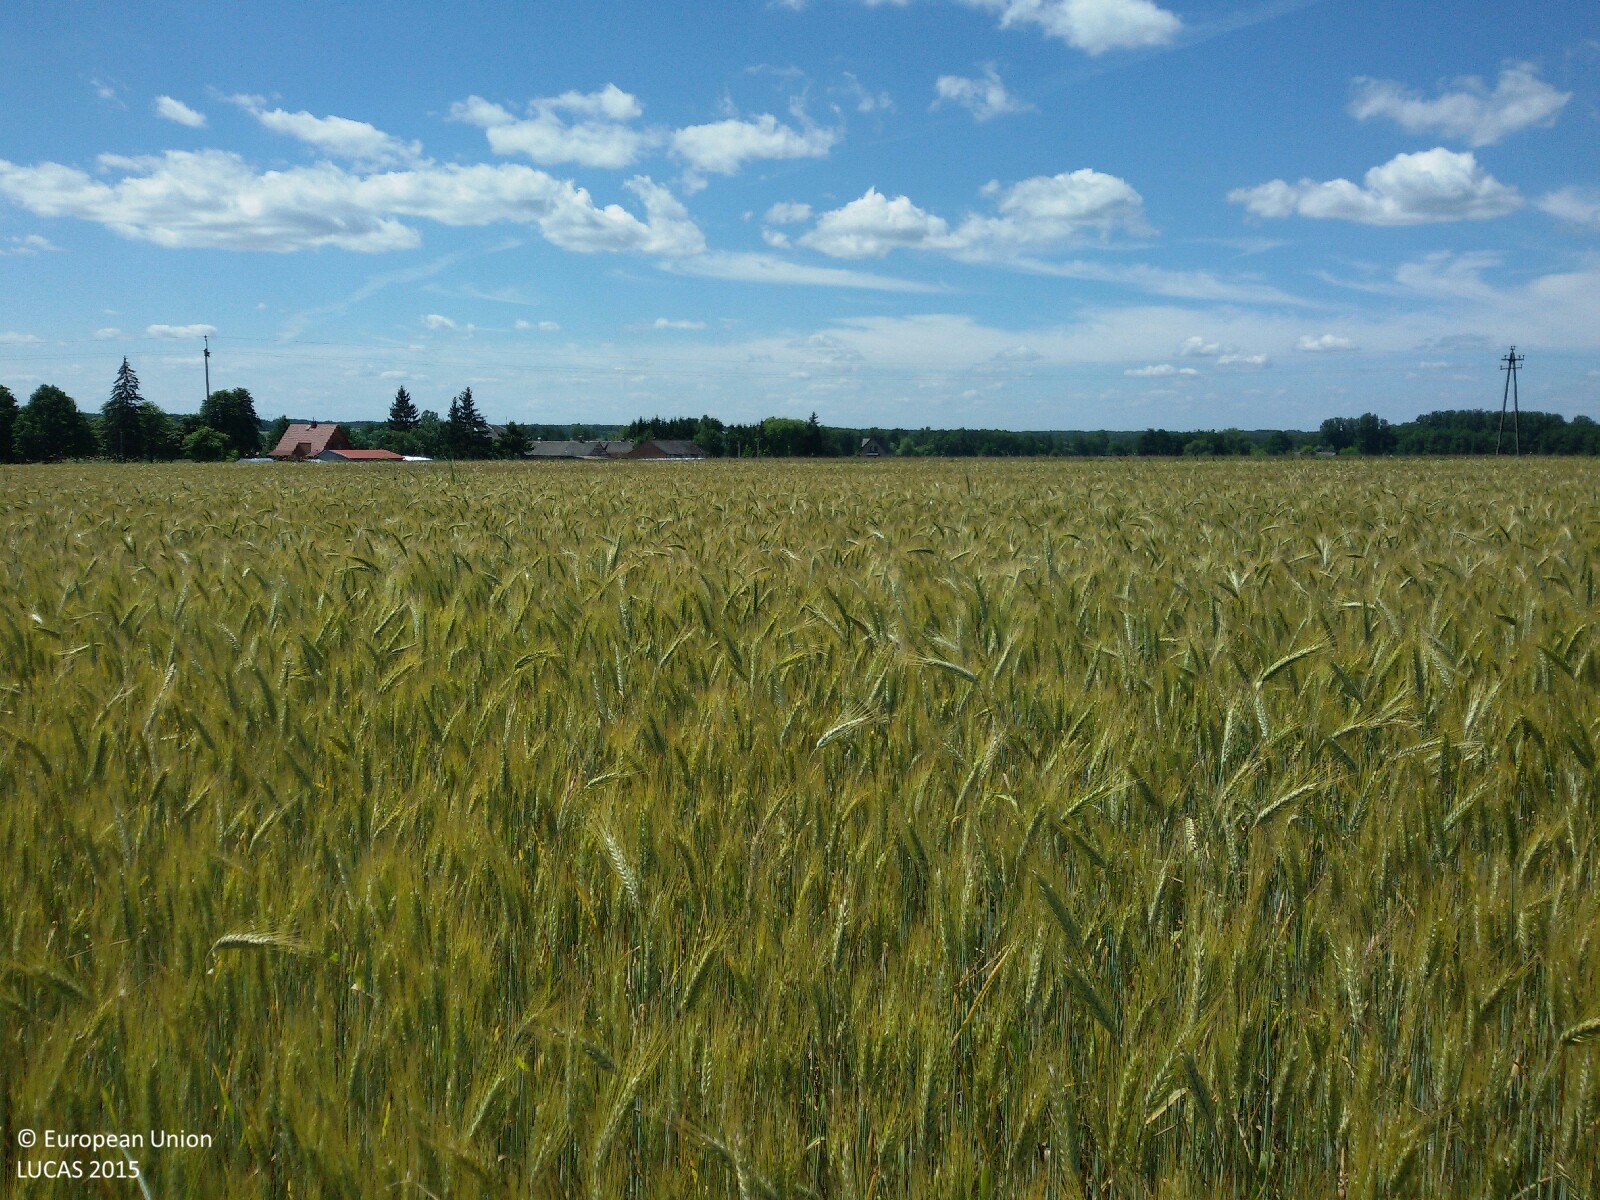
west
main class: Cropland
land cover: Rye
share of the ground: > 75 %
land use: Agriculture (excluding fallow land and kitchen gardens)
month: July
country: PL
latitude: 51.7791
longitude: 21.6929
